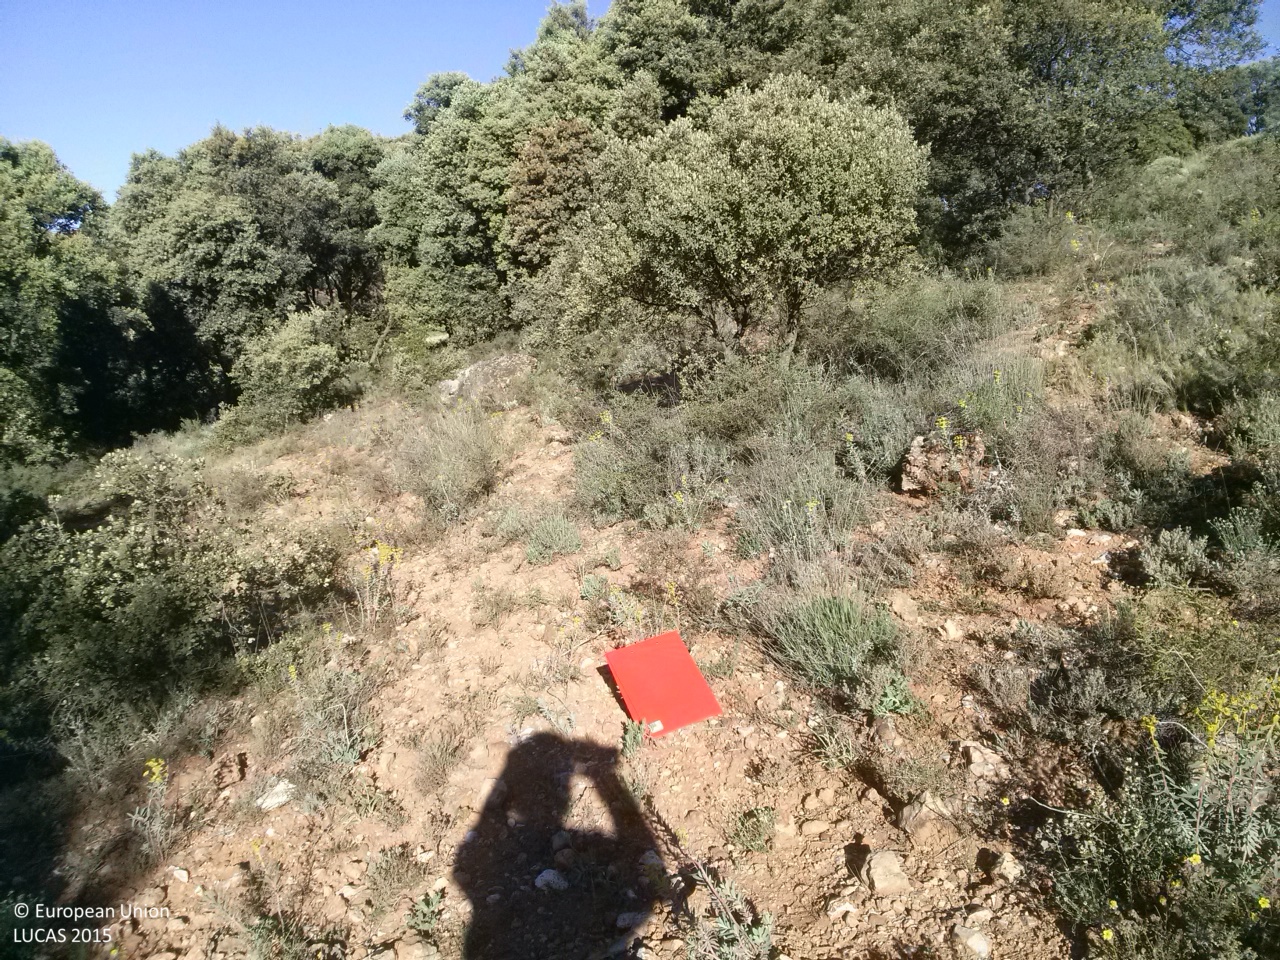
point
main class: Woodland
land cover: Broadleaved woodland
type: broadleaved evergreen forest
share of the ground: 10 - 25 %
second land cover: Shrubland without tree cover
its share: 25 - 50 %
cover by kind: shrubs 30 %, broadleaved forest trees 25 %, unconsolidated bare surface 25 %, herbaceous plants 20 %
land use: Forestry
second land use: Agriculture (excluding fallow land and kitchen gardens)
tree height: > 5 m
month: May
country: ES
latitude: 40.3226
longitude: -2.5091
